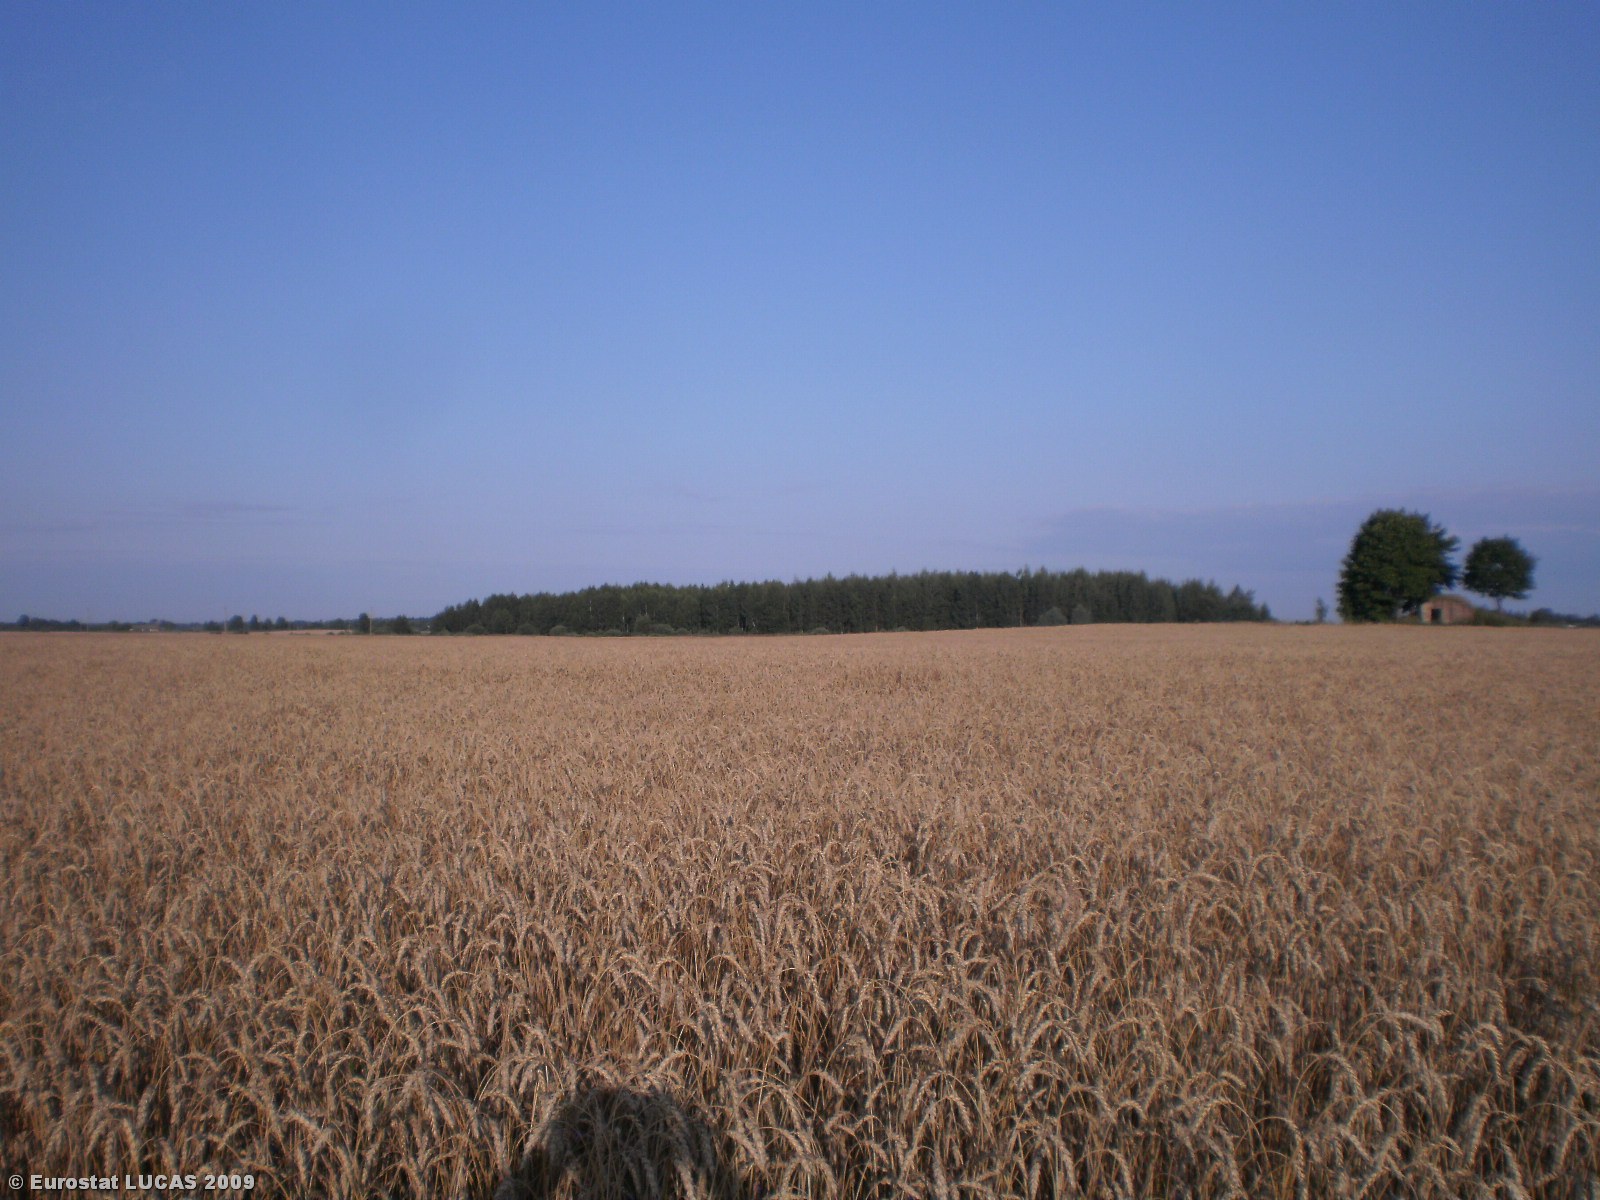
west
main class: Cropland
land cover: Common wheat
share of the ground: > 75 %
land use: Agriculture (excluding fallow land and kitchen gardens)
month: August
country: LT
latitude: 55.5040
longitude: 24.8156
